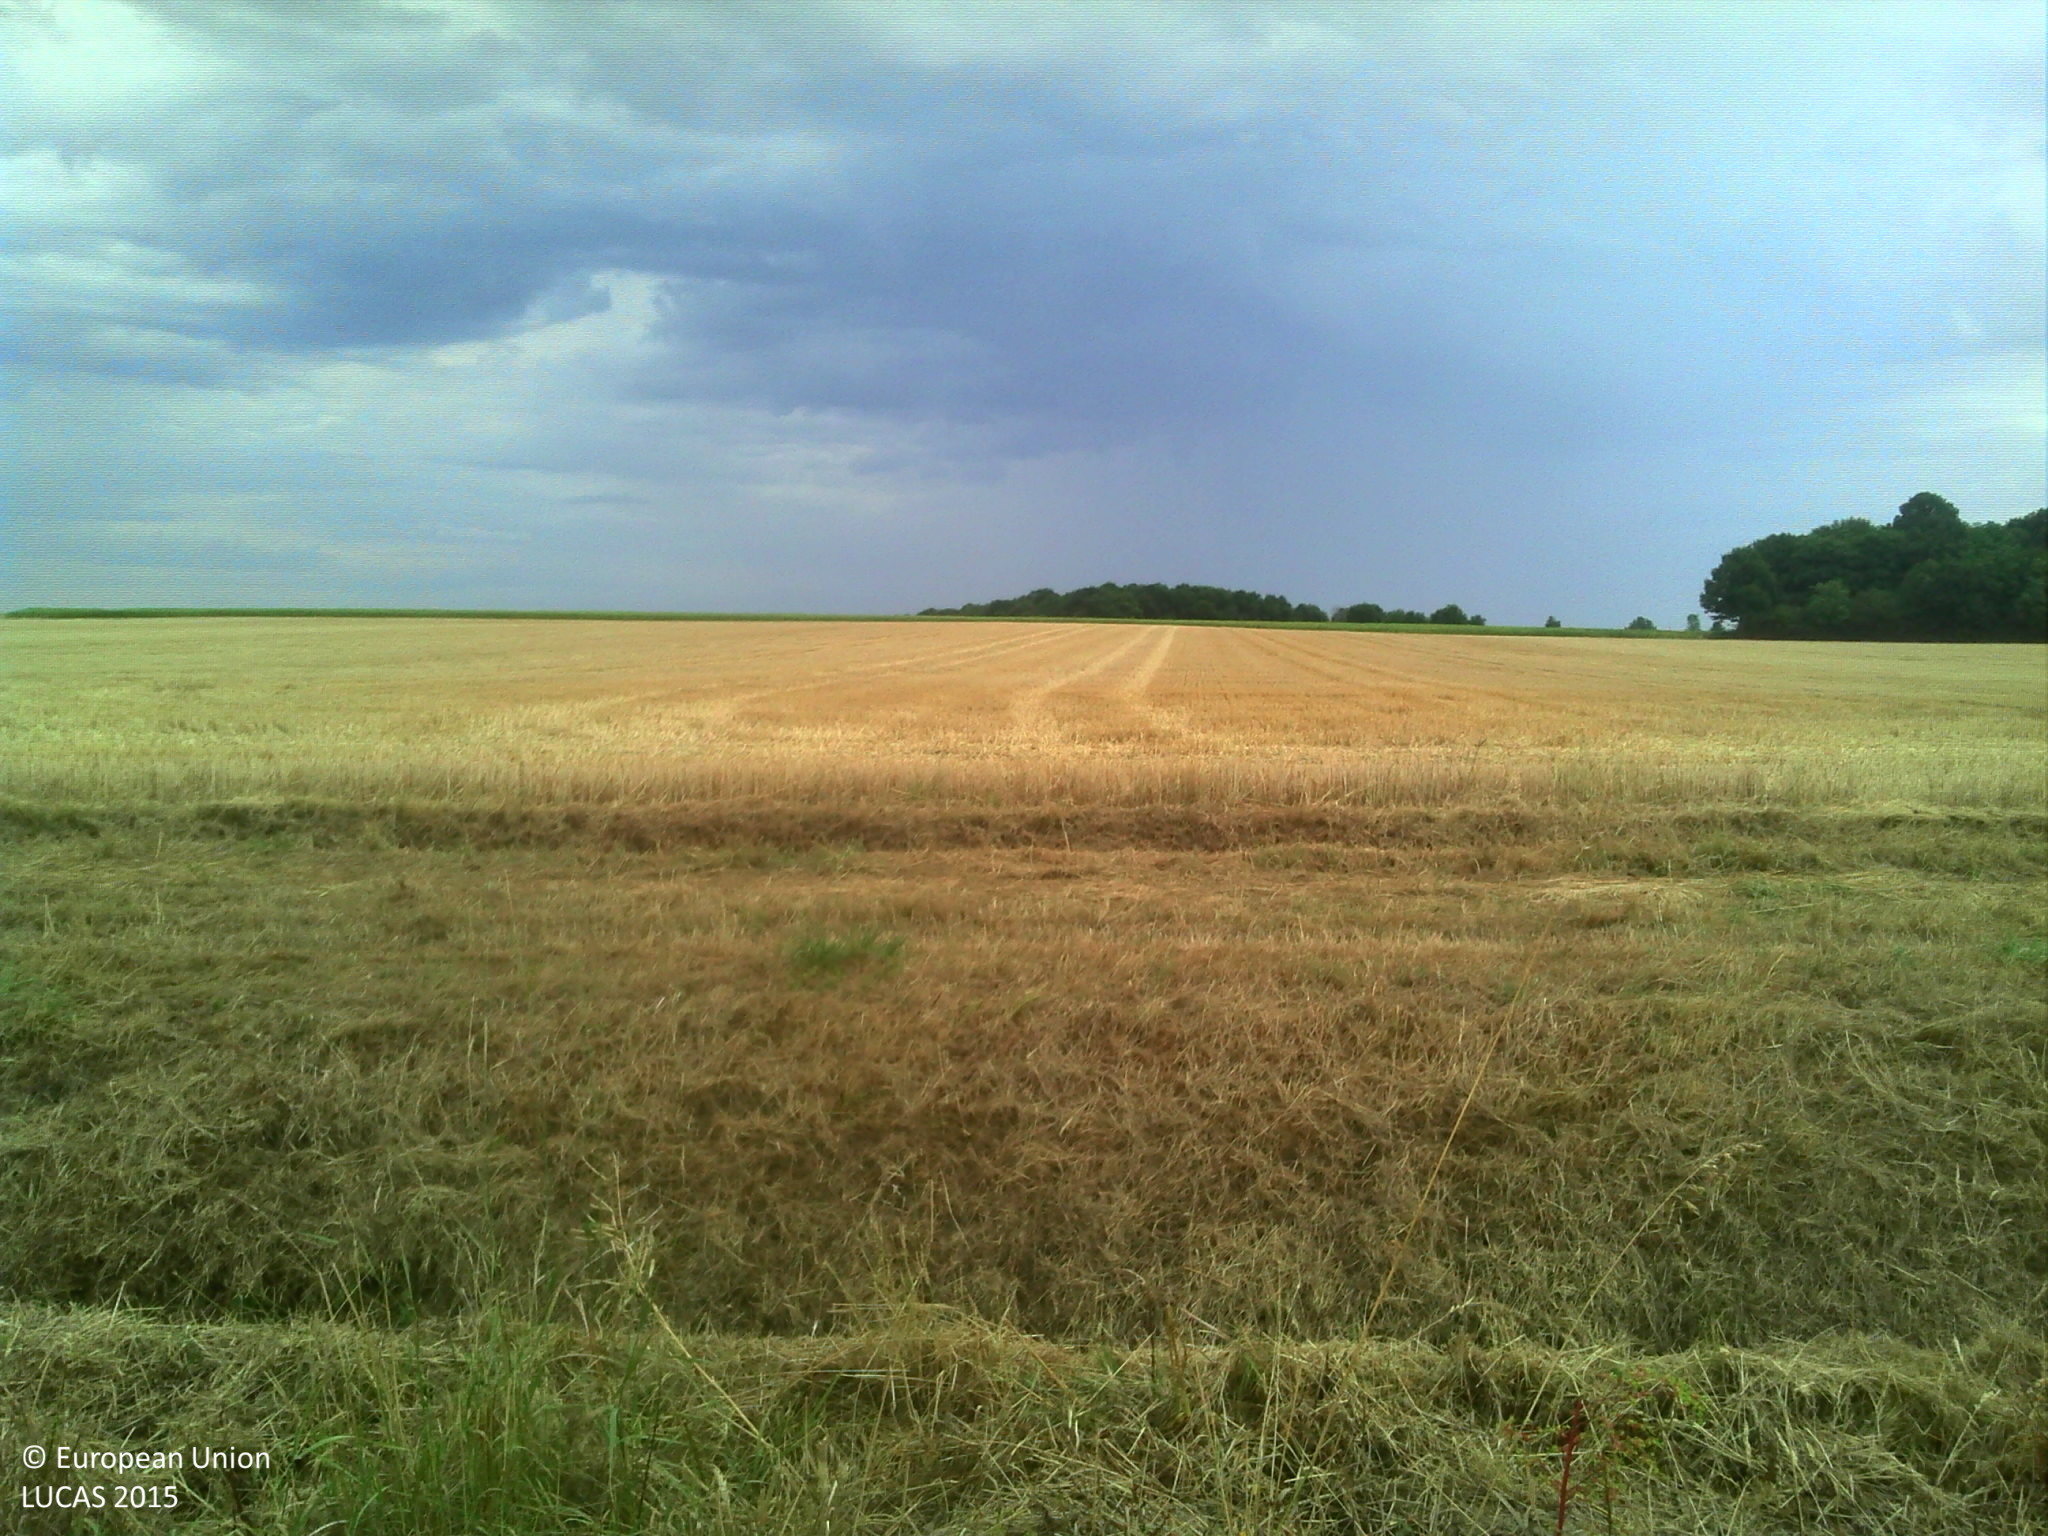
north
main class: Cropland
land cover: Rape and turnip rape
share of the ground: < 10 %
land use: Agriculture (excluding fallow land and kitchen gardens)
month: July
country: FR
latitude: 46.9112
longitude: 4.8148
